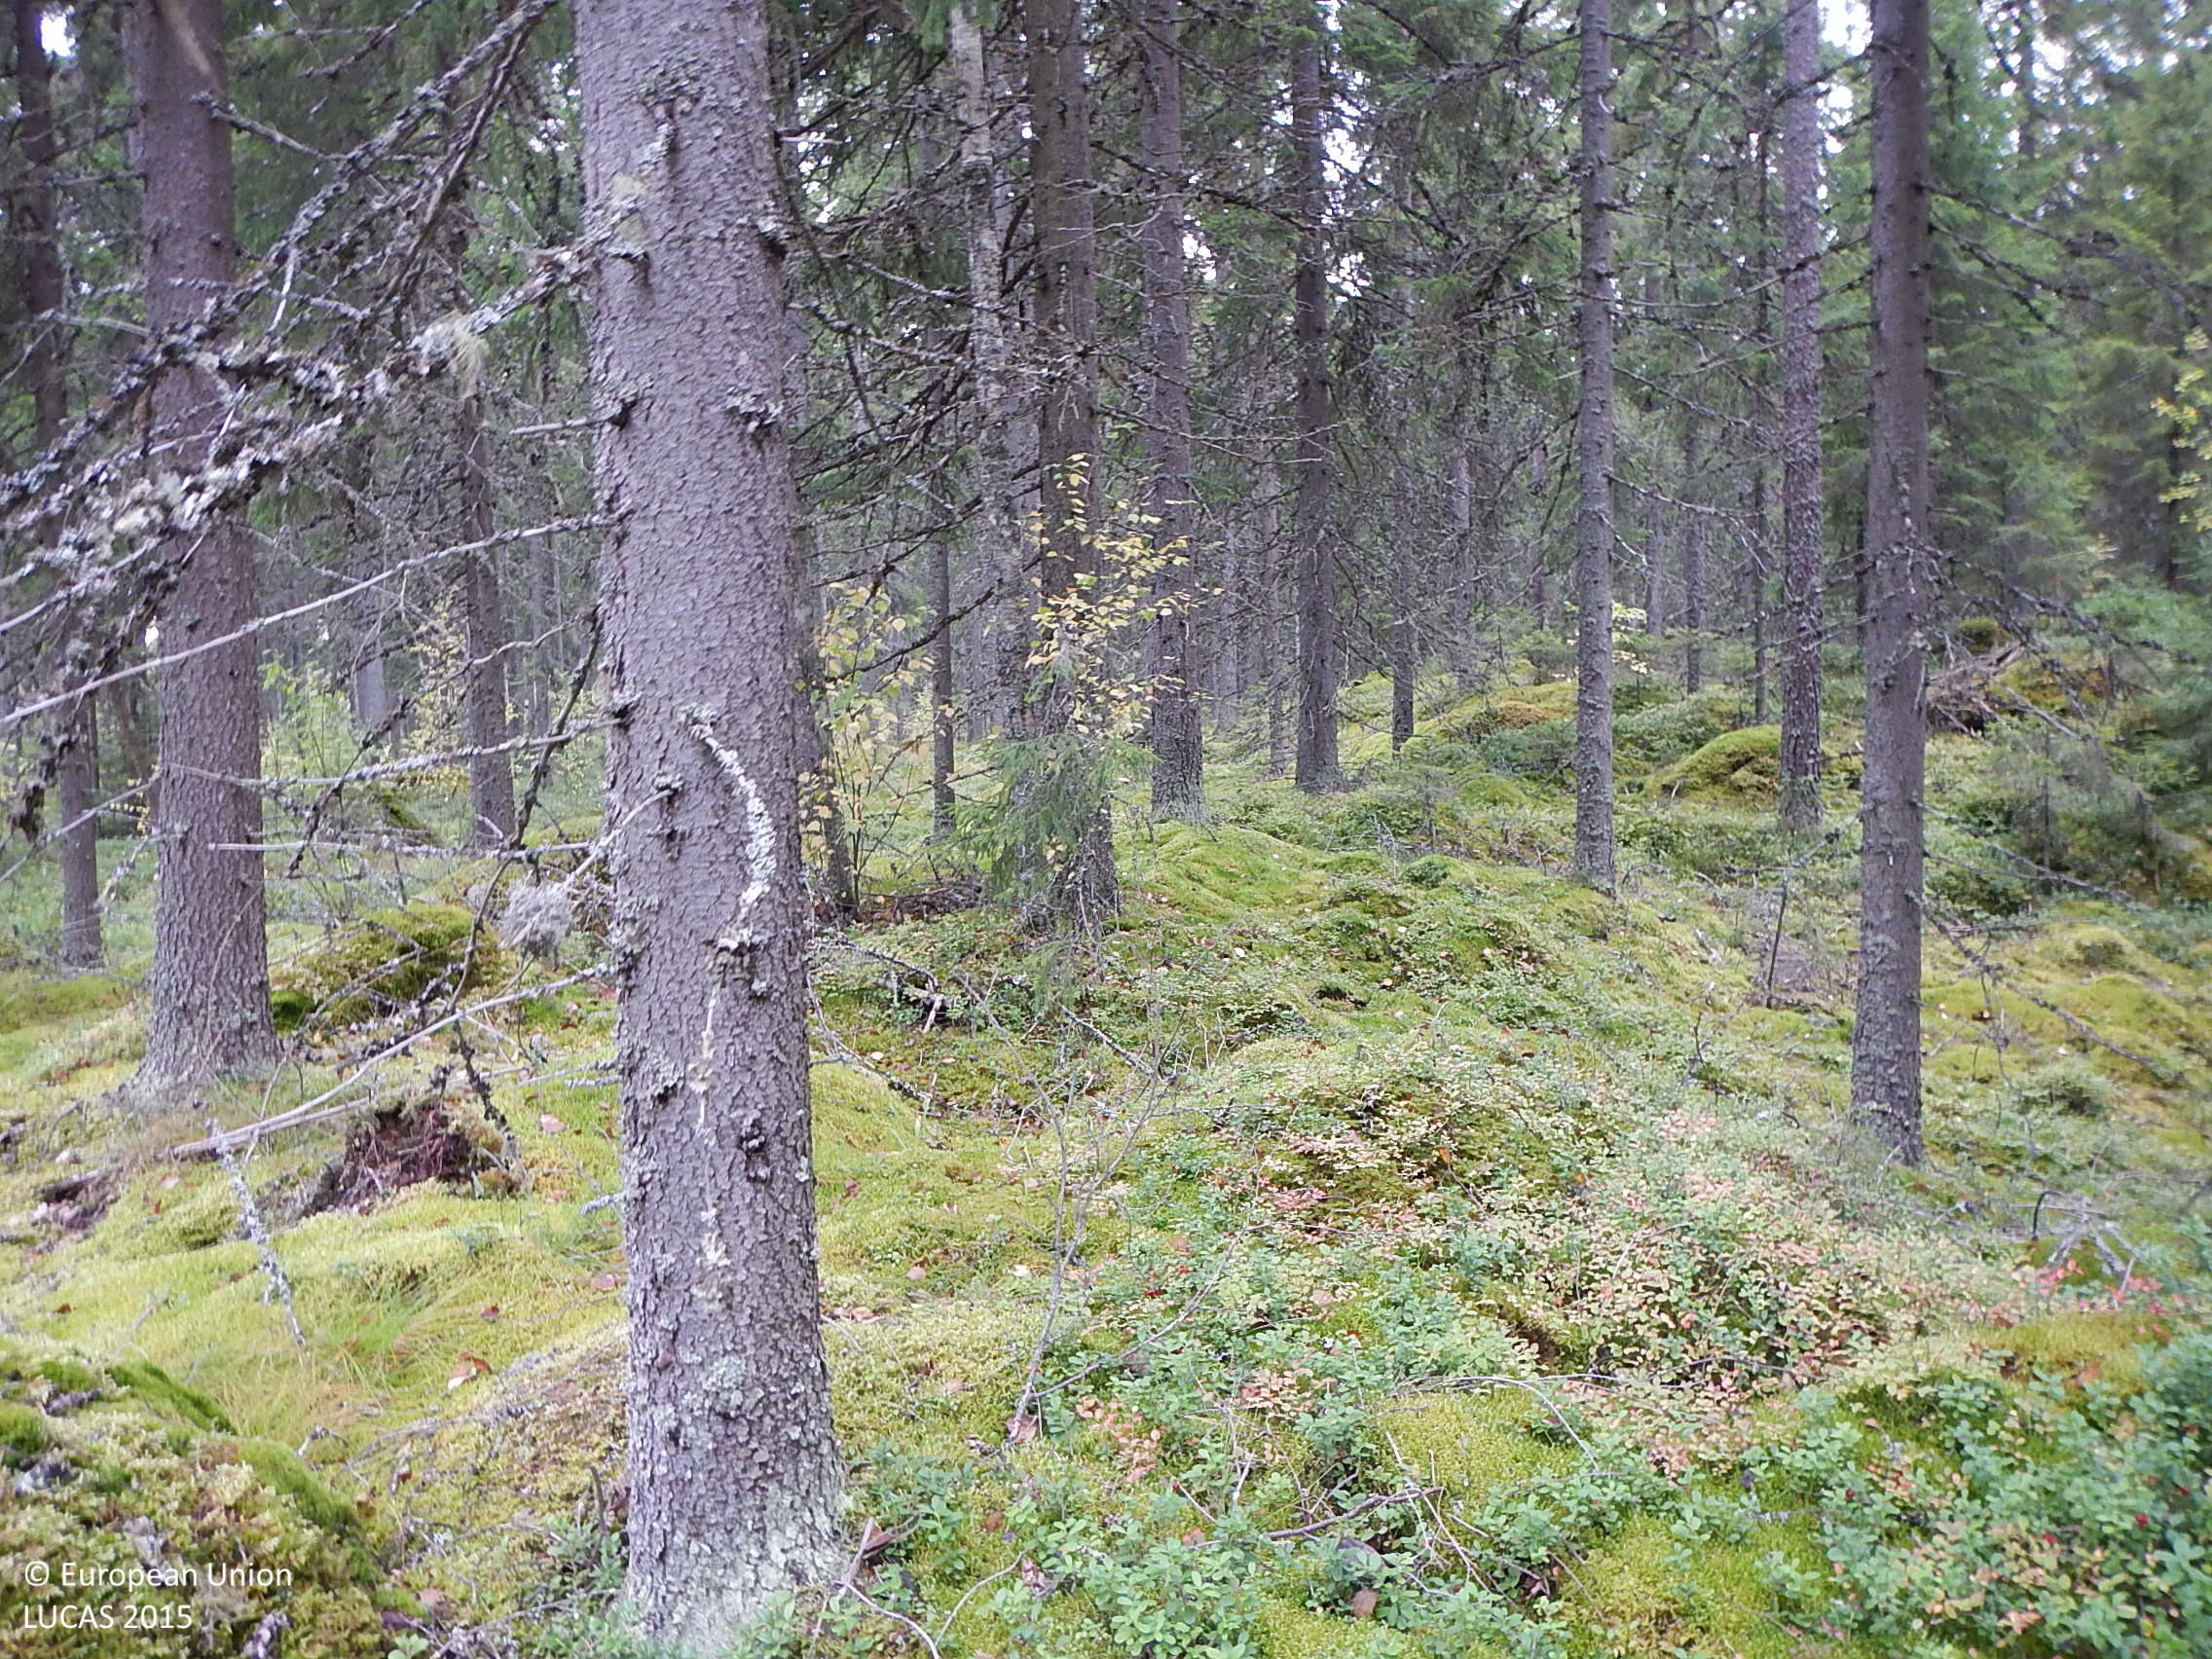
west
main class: Woodland
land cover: Spruce dominated coniferous woodland
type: boreal forest
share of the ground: 50 - 75 %
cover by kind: coniferous forest trees 40 %, shrubs 40 %, broadleaved forest trees 10 %, lichens and mosses 10 %
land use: Forestry
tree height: > 5 m
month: September
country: FI
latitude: 61.8426
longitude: 22.8117
